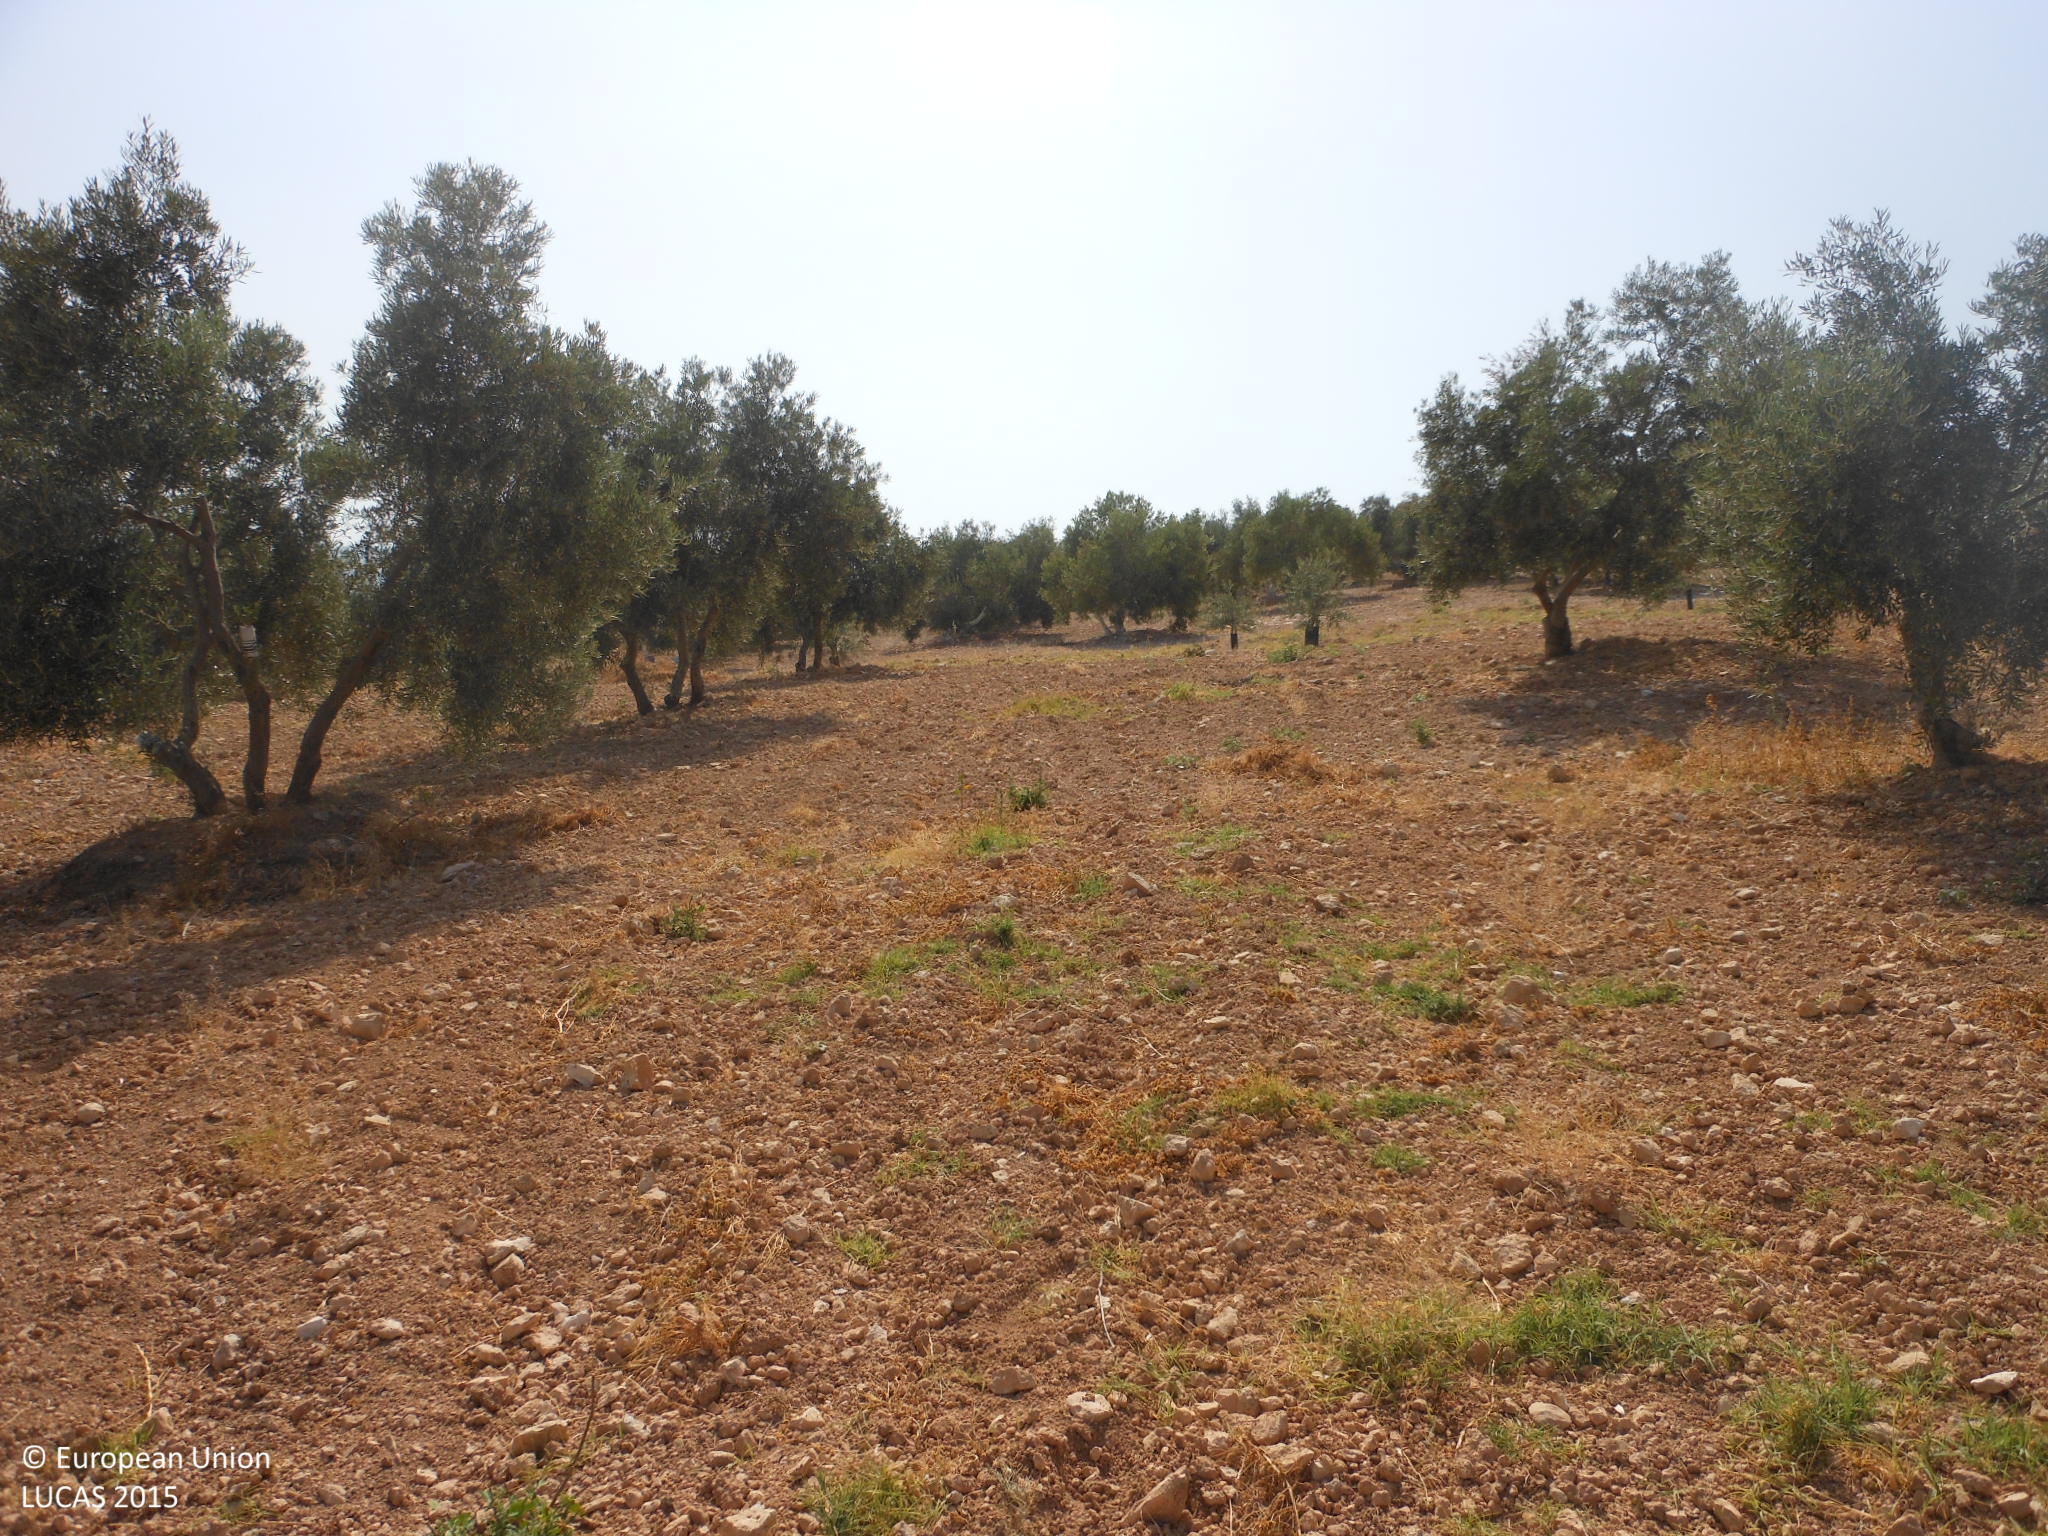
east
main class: Cropland
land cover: Olive groves
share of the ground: 25 - 50 %
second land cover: Other bare soil
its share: > 75 %
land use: Agriculture (excluding fallow land and kitchen gardens)
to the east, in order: Olive groves; Other bare soil; Tracks; Olive groves
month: July
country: ES
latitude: 37.0987
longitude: -5.0248
